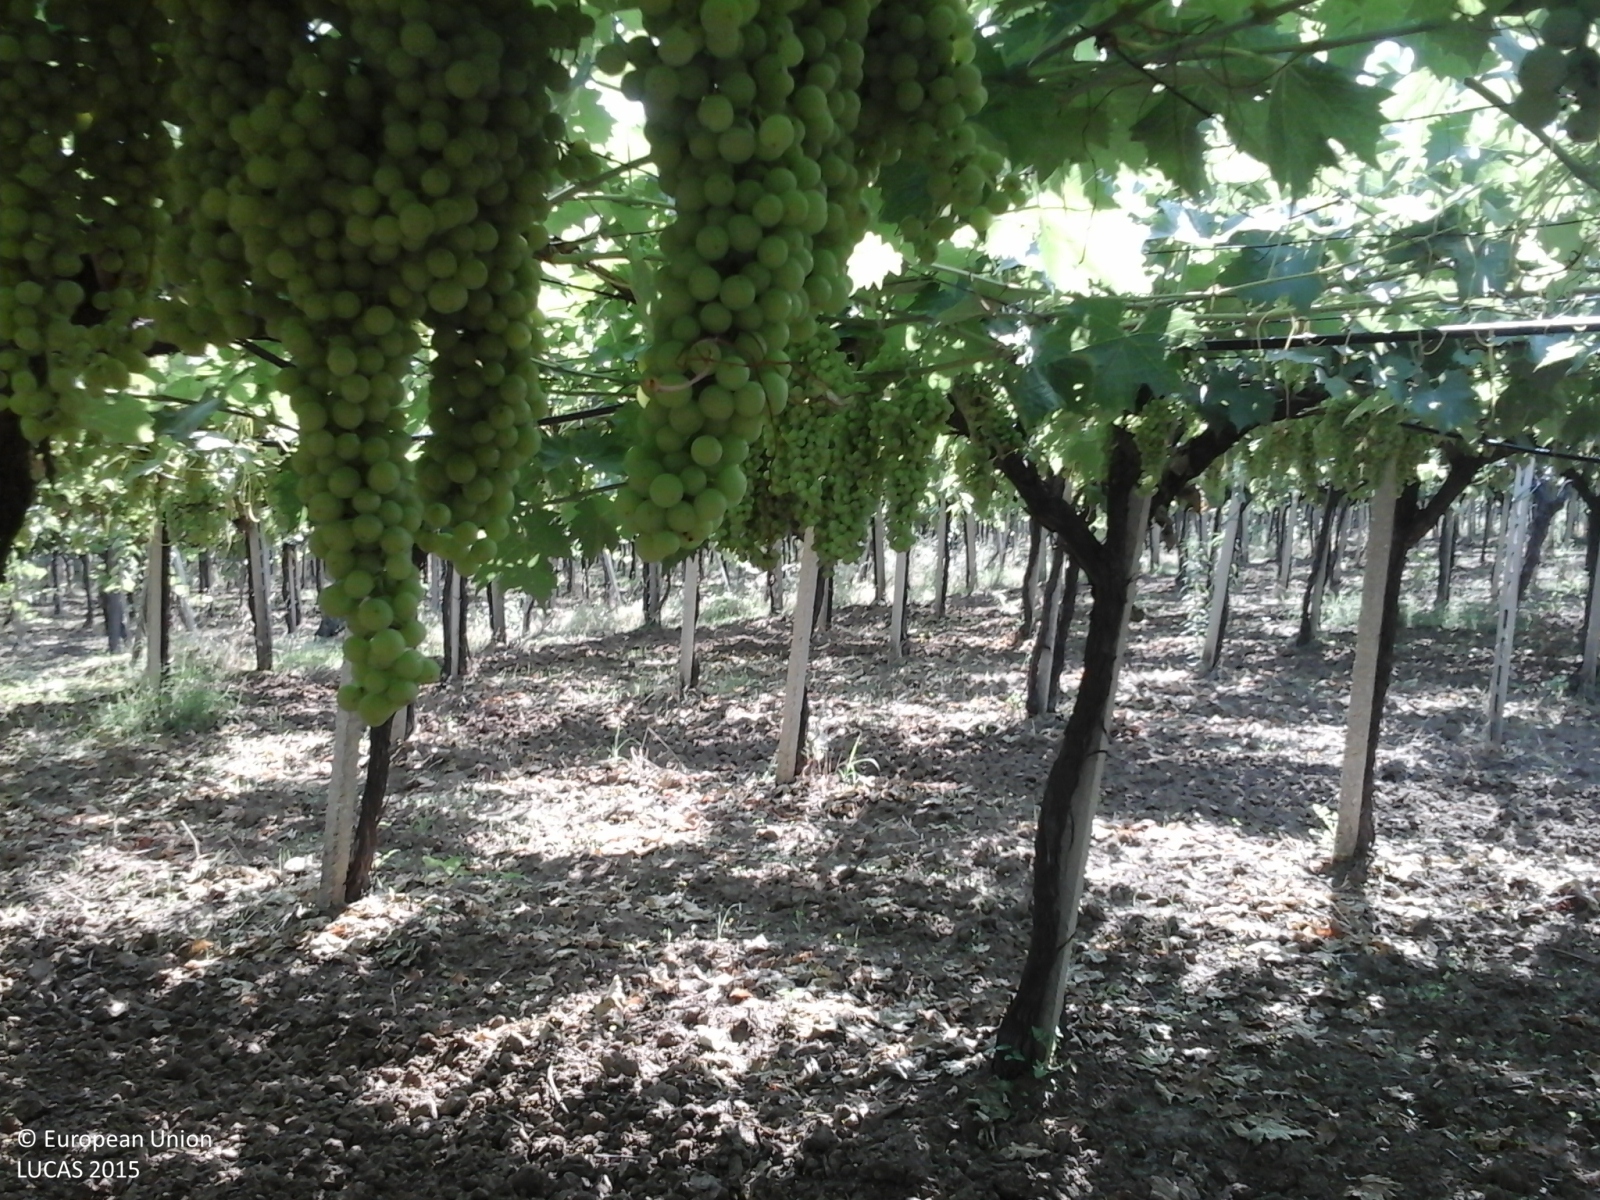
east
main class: Cropland
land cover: Vineyards
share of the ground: 25 - 50 %
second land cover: Spontaneously vegetated surfaces
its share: 25 - 50 %
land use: Agriculture (excluding fallow land and kitchen gardens)
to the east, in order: Vineyards; Spontaneously vegetated surfaces; Vineyards; Olive groves; Vineyards; Tracks; Vineyards
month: July
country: IT
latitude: 42.3629
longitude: 14.3218
